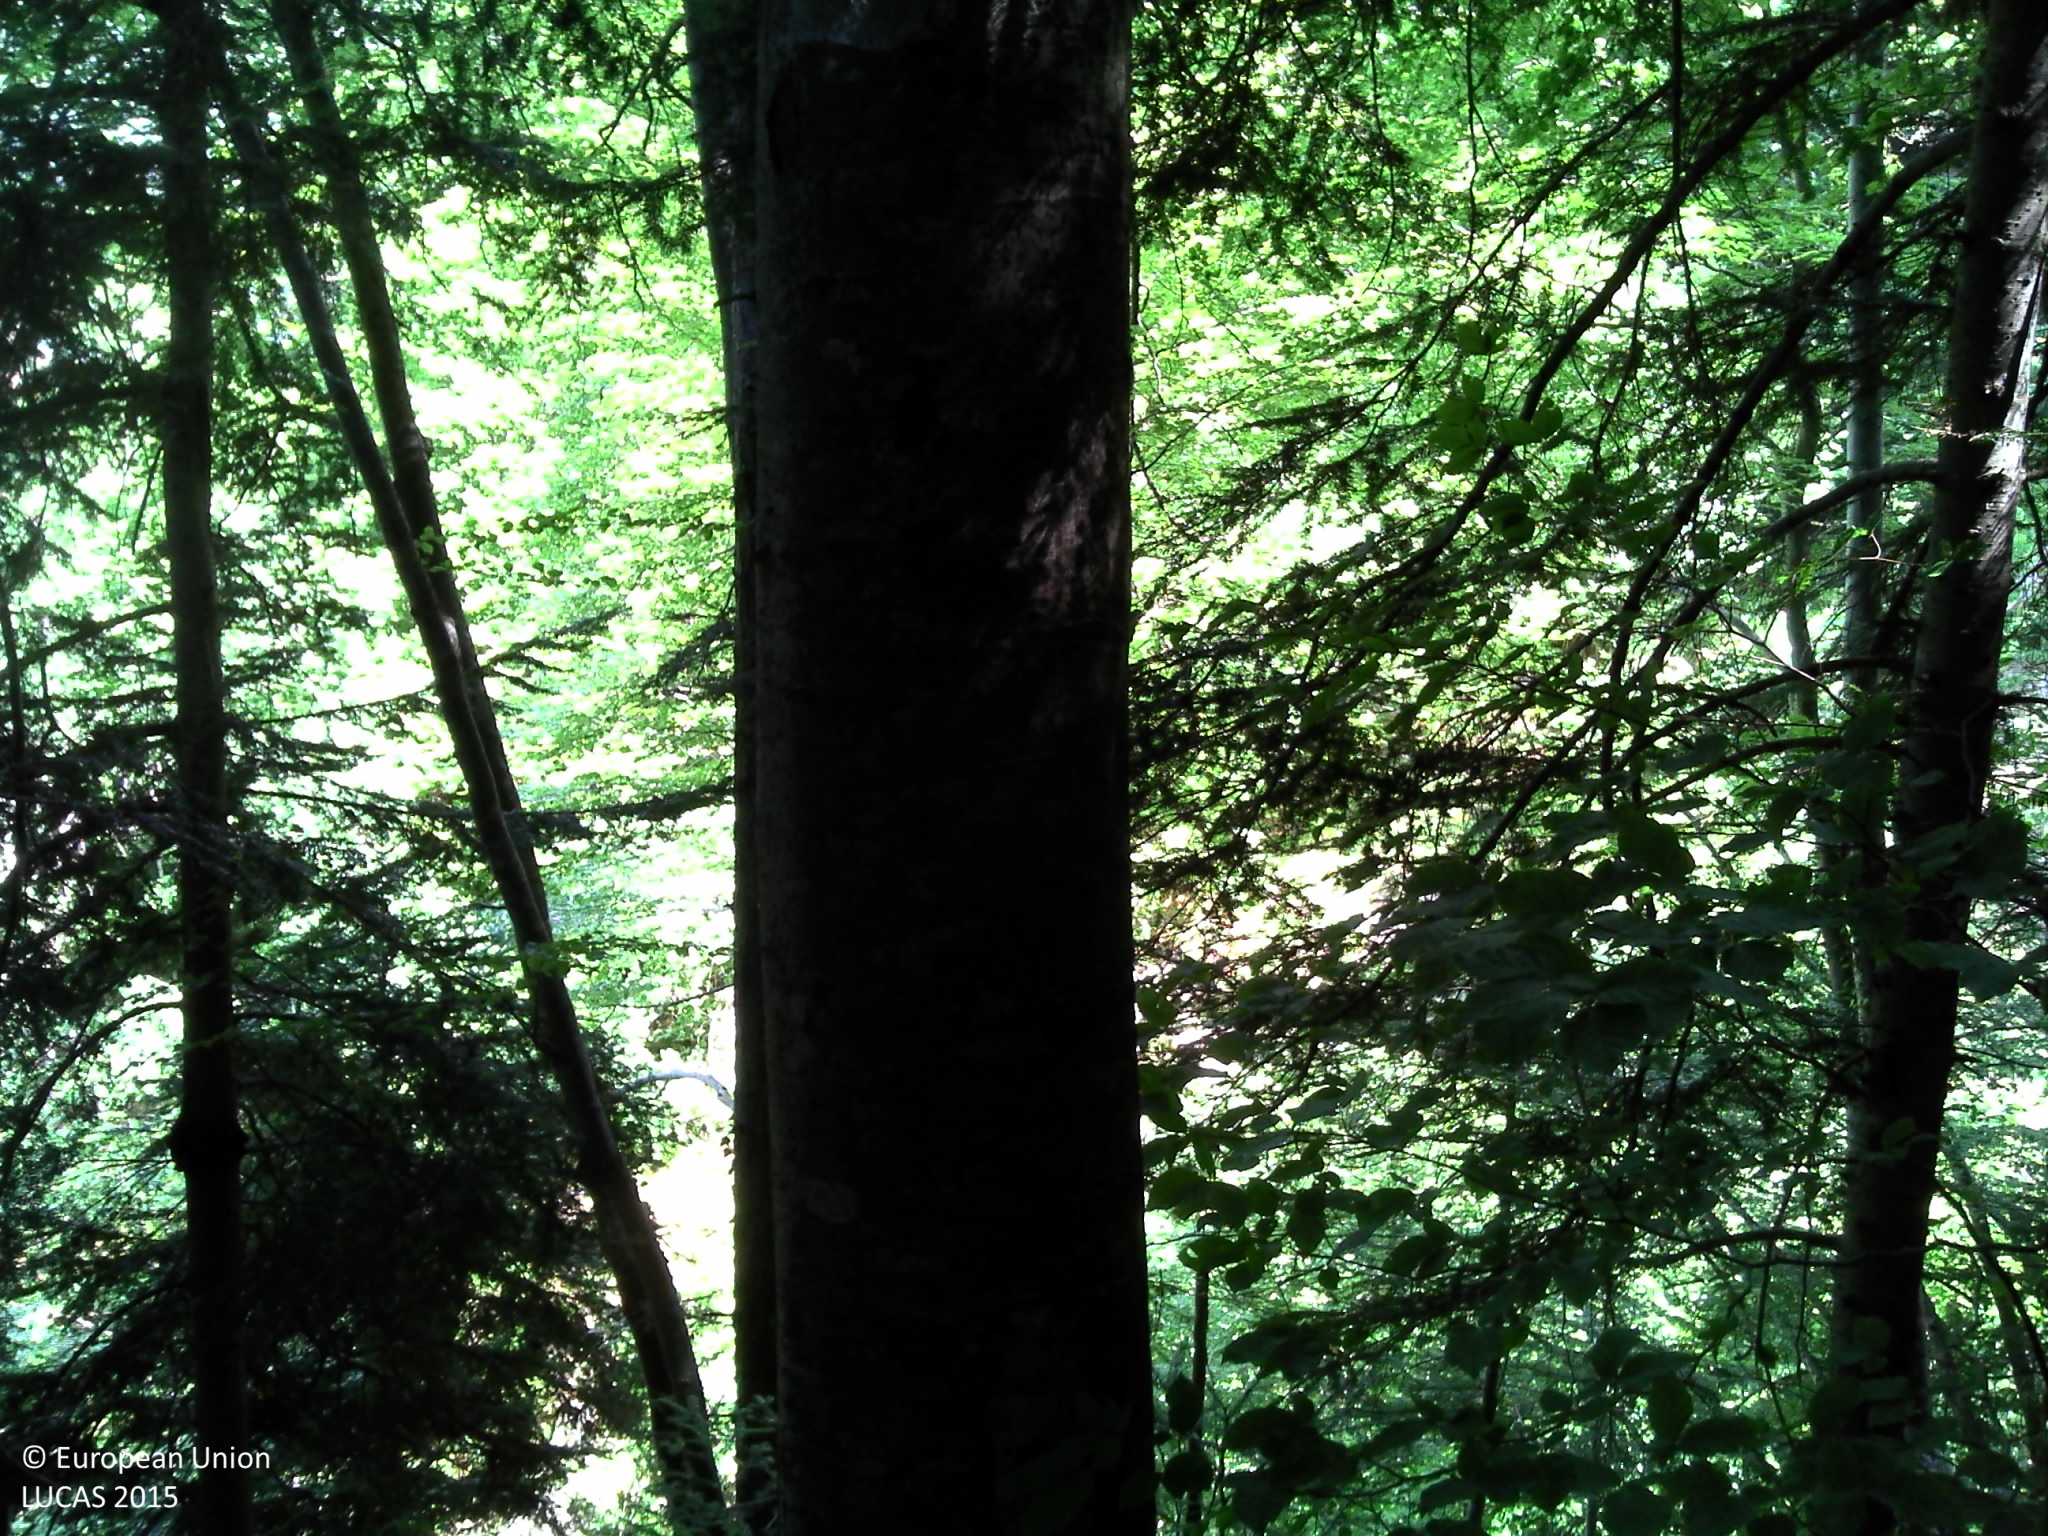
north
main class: Woodland
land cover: Other mixed woodland
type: mountainous beech forest
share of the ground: > 75 %
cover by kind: broadleaved forest trees 75 %, coniferous forest trees 25 %
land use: Forestry
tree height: > 5 m
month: July
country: FR
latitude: 42.8930
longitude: -0.1044
